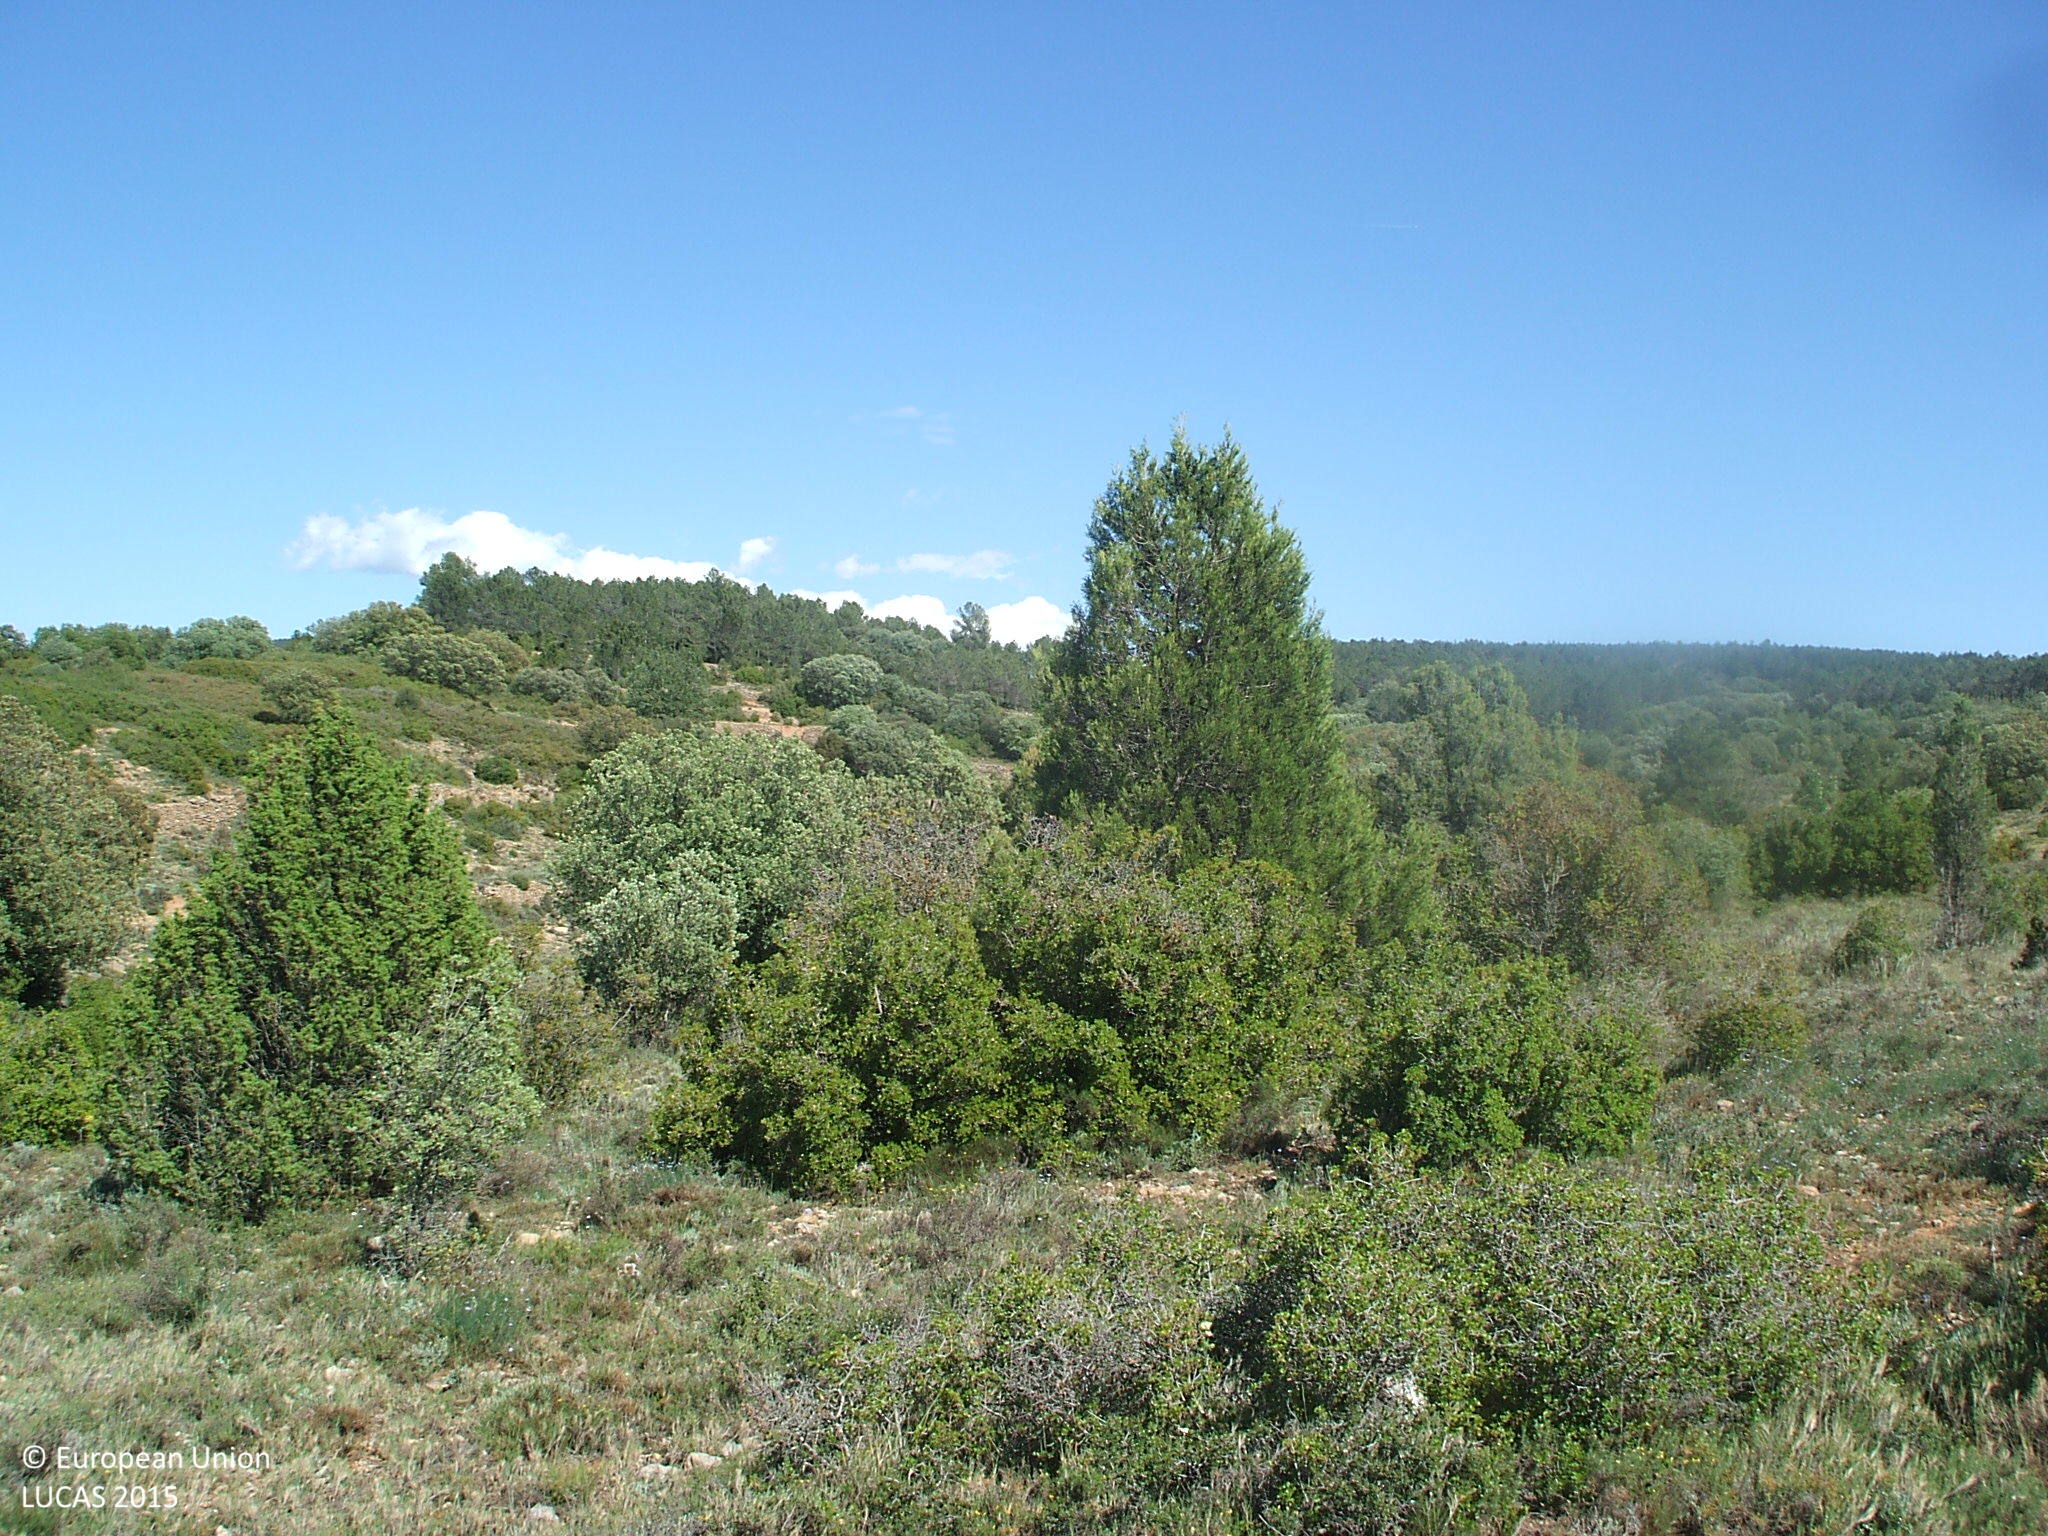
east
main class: Woodland
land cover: Other mixed woodland
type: coniferous forest of the mediterranean region
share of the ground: 25 - 50 %
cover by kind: herbaceous plants 40 %, unconsolidated bare surface 25 %, coniferous forest trees 15 %, broadleaved forest trees 15 %, shrubs 5 %
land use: Semi-natural and natural areas not in use
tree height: < 5 m
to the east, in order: Other mixed woodland; Dry stone walls; Other mixed woodland; Dry stone walls; Shrubland with sparse tree cover; Dry stone walls; Grassland with sparse tree/shrub cover; Dry stone walls; Grass margins; Rivers and streams; Grass margins; Dry stone walls; Broadleaved woodland; Dry stone walls; Broadleaved woodland
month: May
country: ES
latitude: 40.0445
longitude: -0.7061
